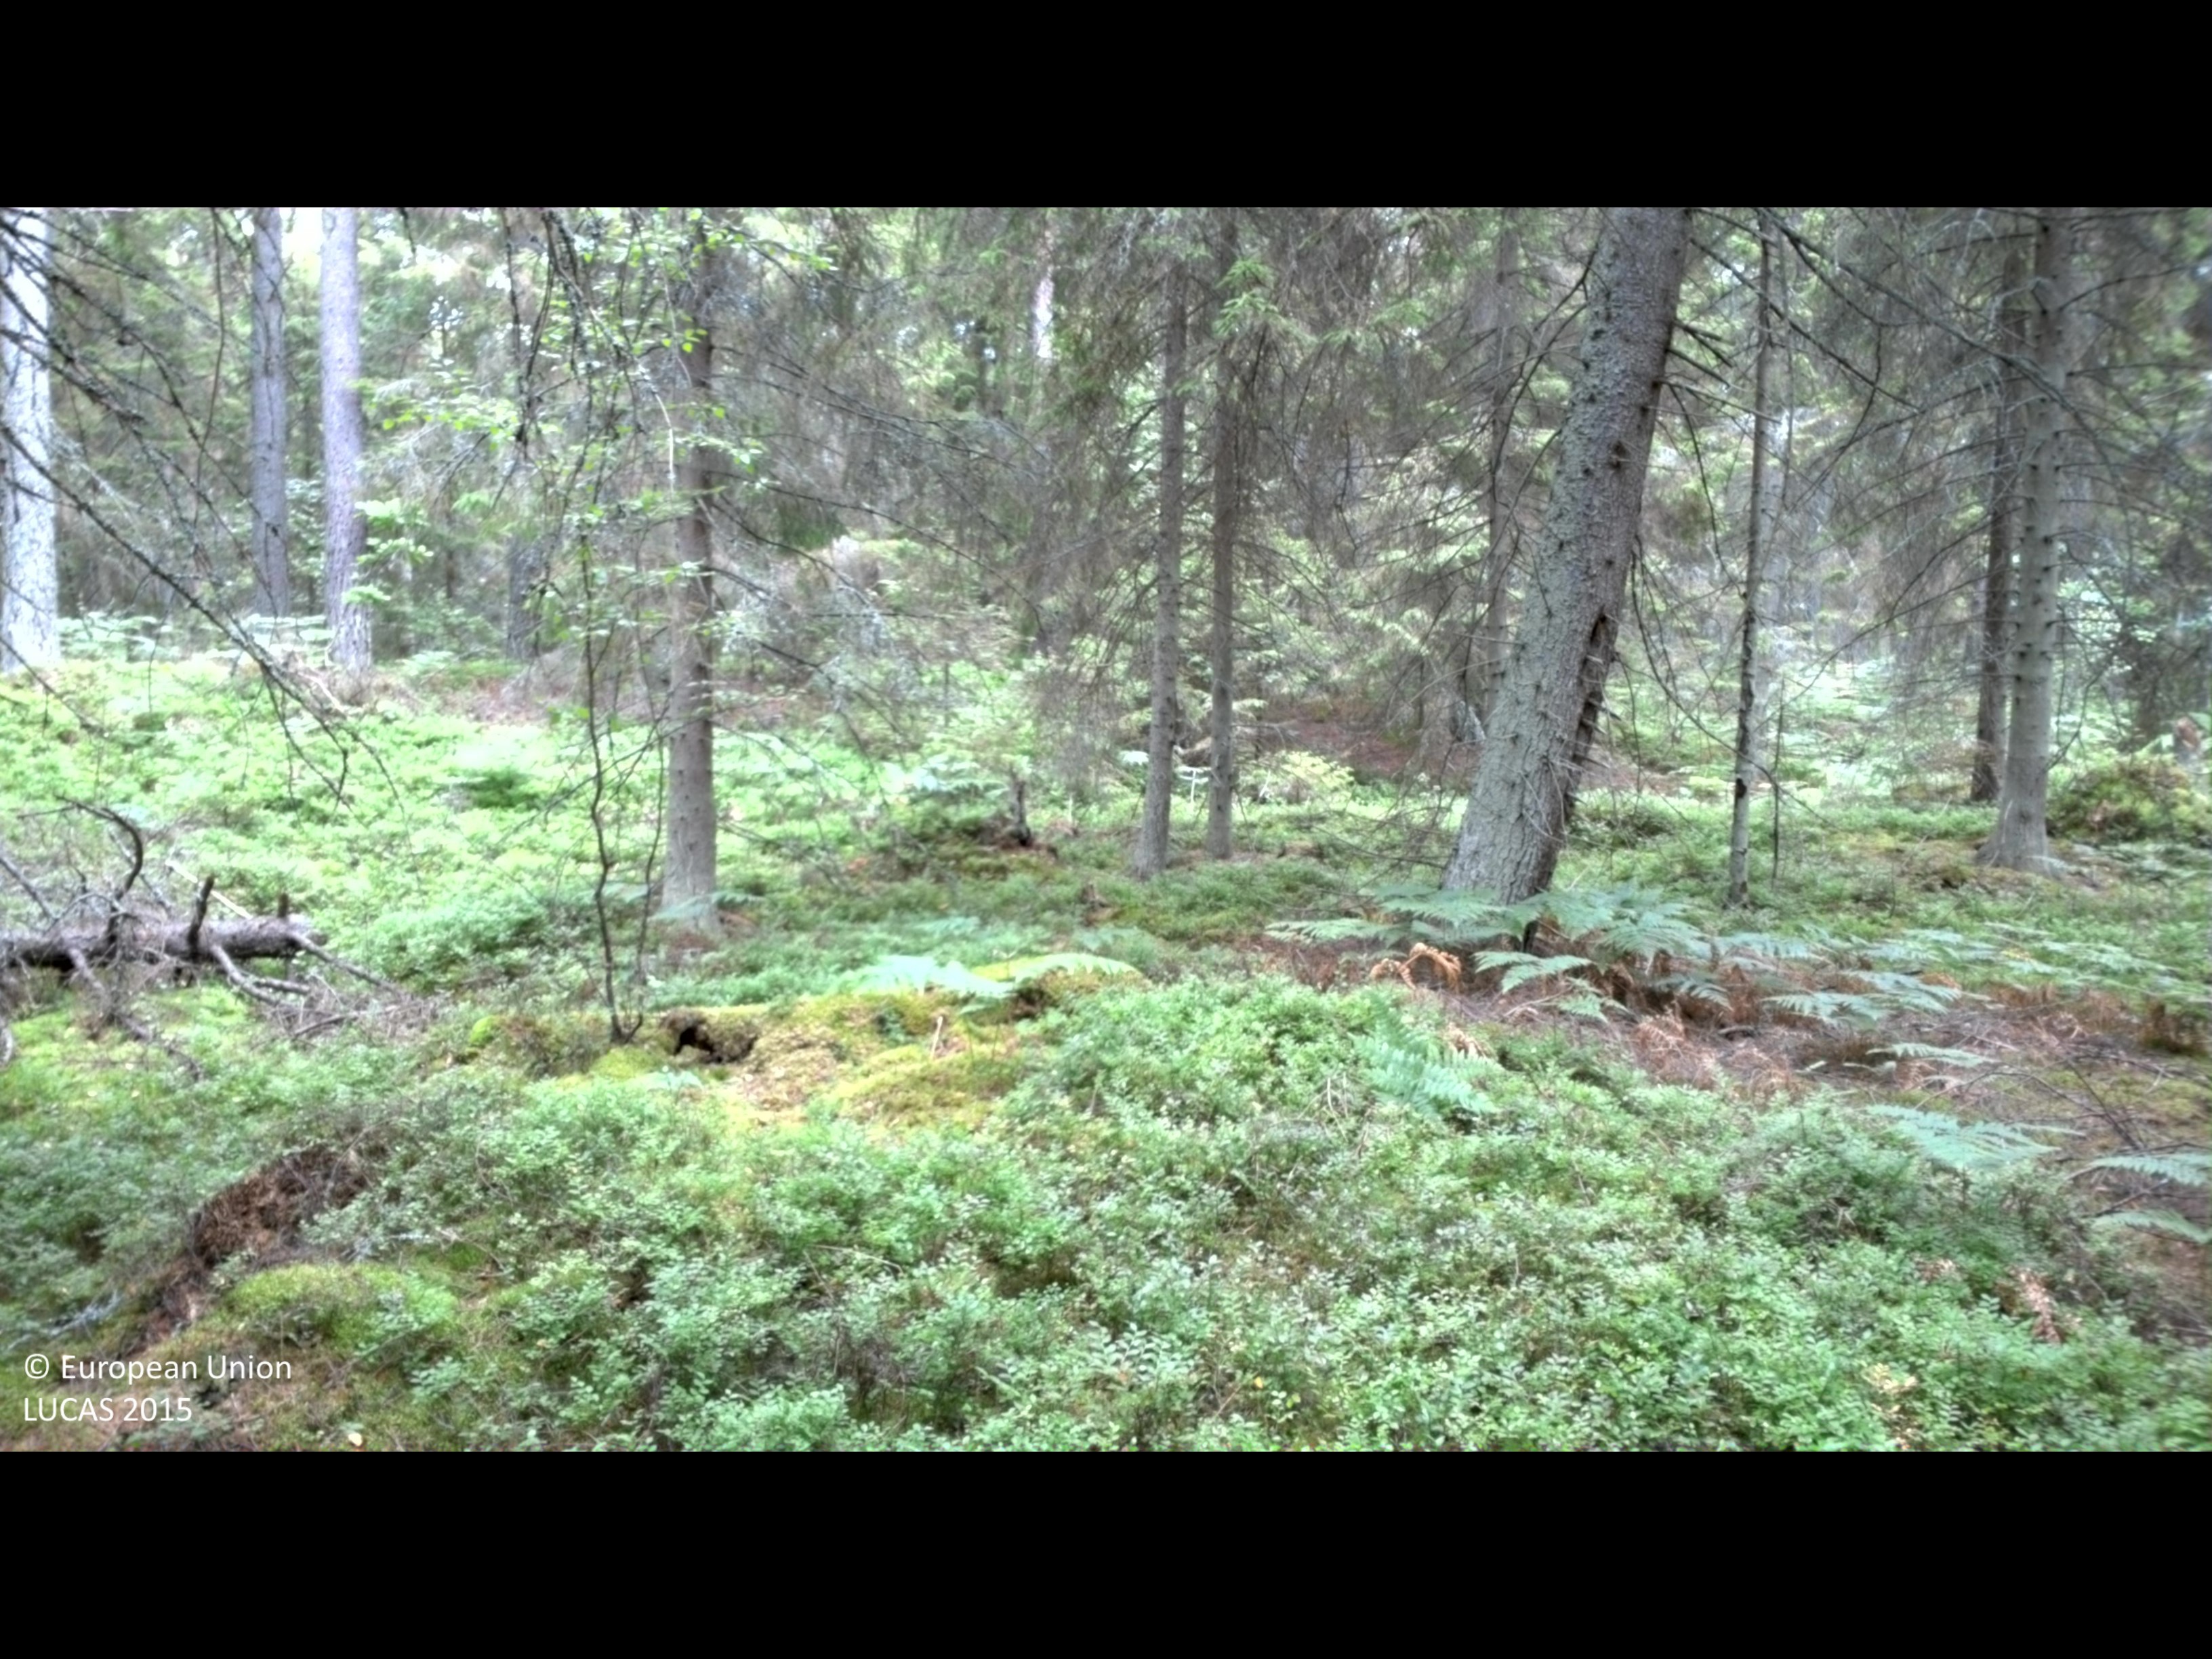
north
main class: Woodland
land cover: Spruce dominated coniferous woodland
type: boreal forest
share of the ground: > 75 %
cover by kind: coniferous forest trees 75 %, shrubs 15 %, herbaceous plants 5 %, lichens and mosses 5 %
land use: Forestry
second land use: Amenities, museums, leisure
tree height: > 5 m
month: July
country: SE
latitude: 57.2937
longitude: 17.0541
